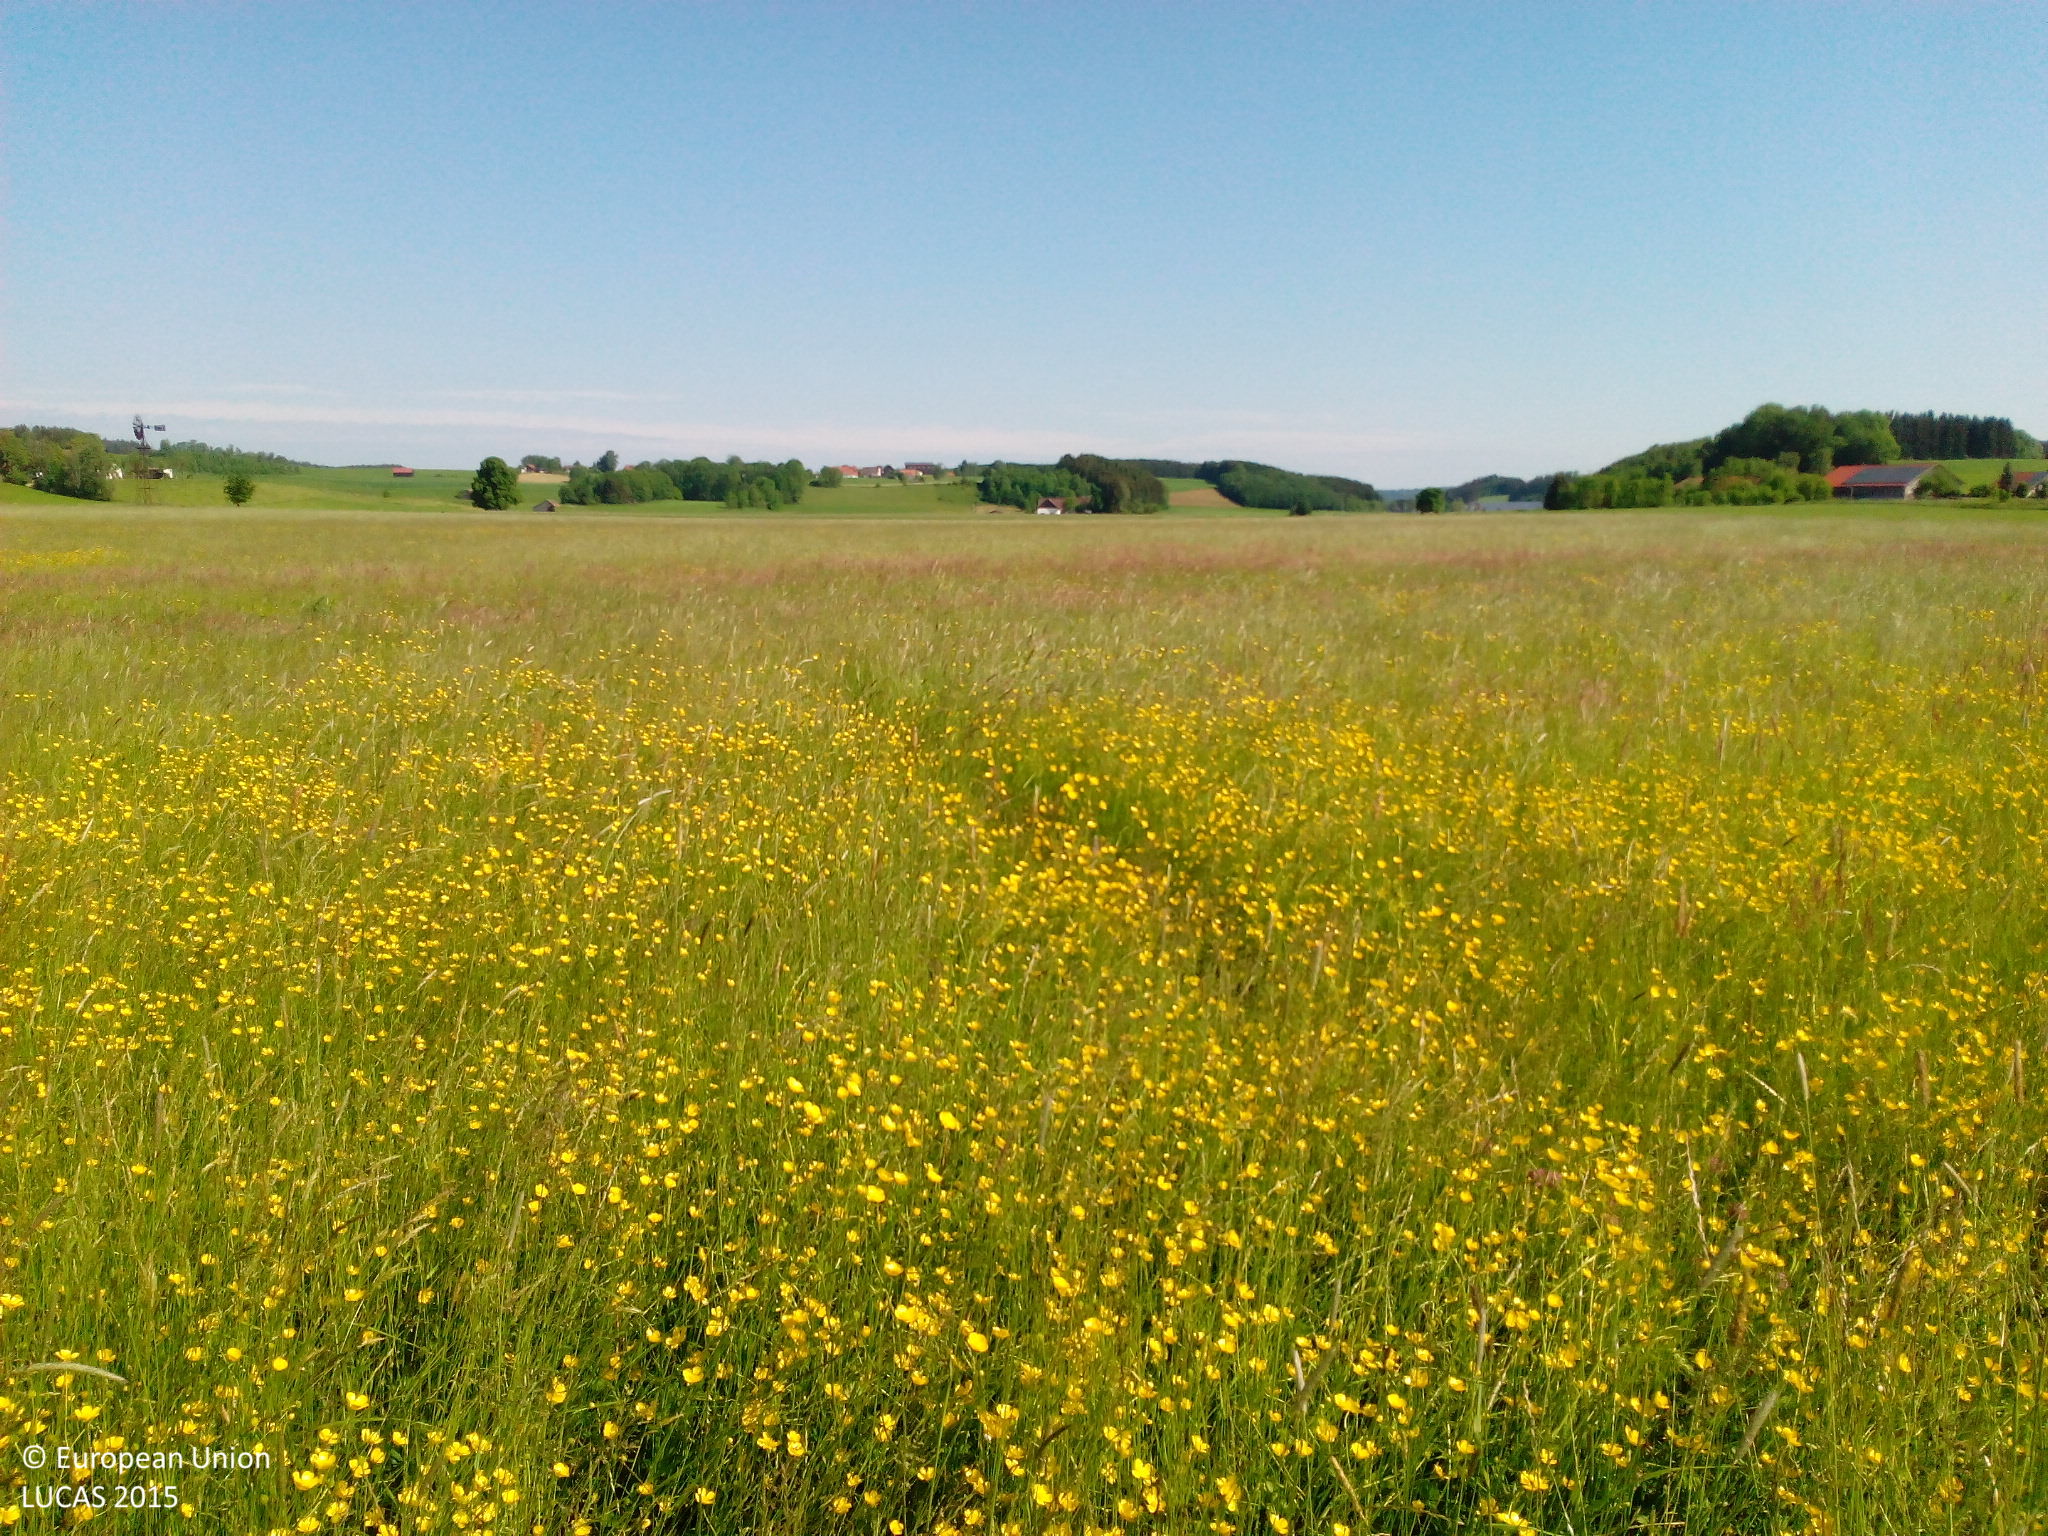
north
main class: Grassland
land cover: Grassland without tree/shrub cover
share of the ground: > 75 %
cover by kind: herbaceous plants 100 %
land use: Agriculture (excluding fallow land and kitchen gardens)
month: June
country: DE
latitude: 47.8453
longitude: 10.2537
